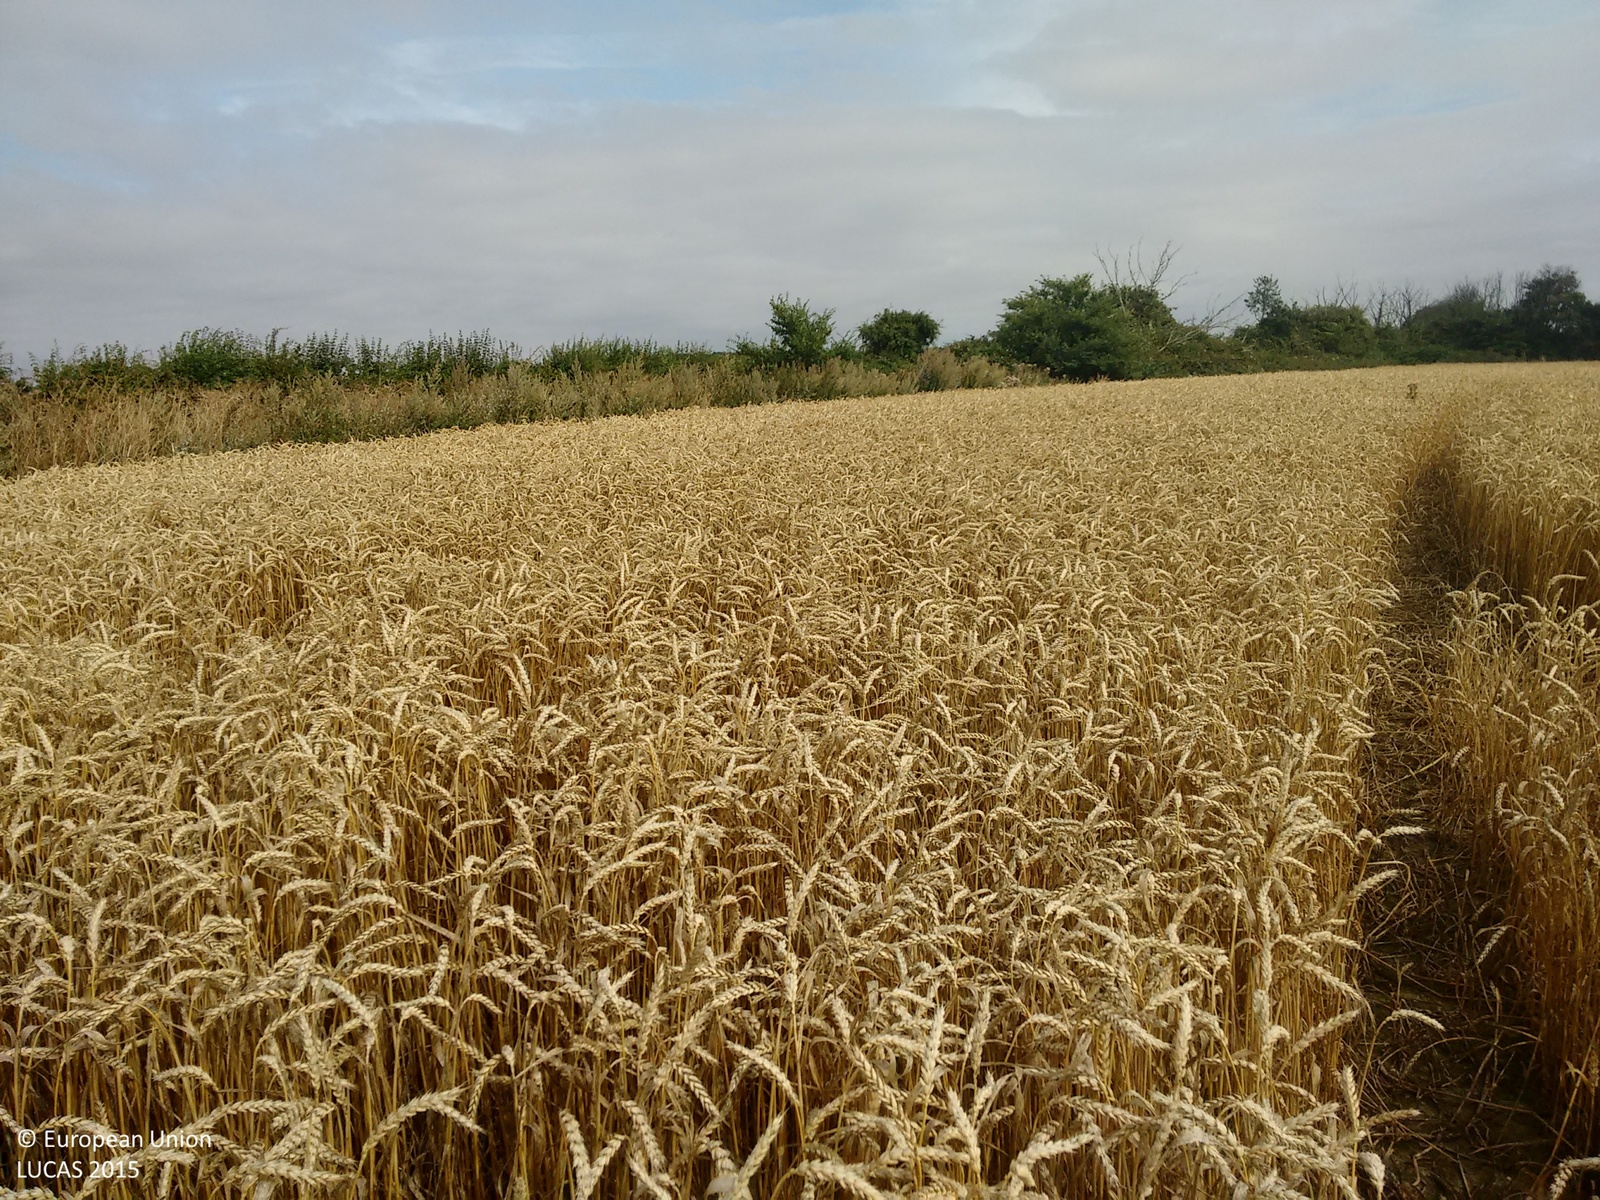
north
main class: Cropland
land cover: Common wheat
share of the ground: > 75 %
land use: Agriculture (excluding fallow land and kitchen gardens)
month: August
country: GB
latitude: 51.8065
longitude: 1.0869
